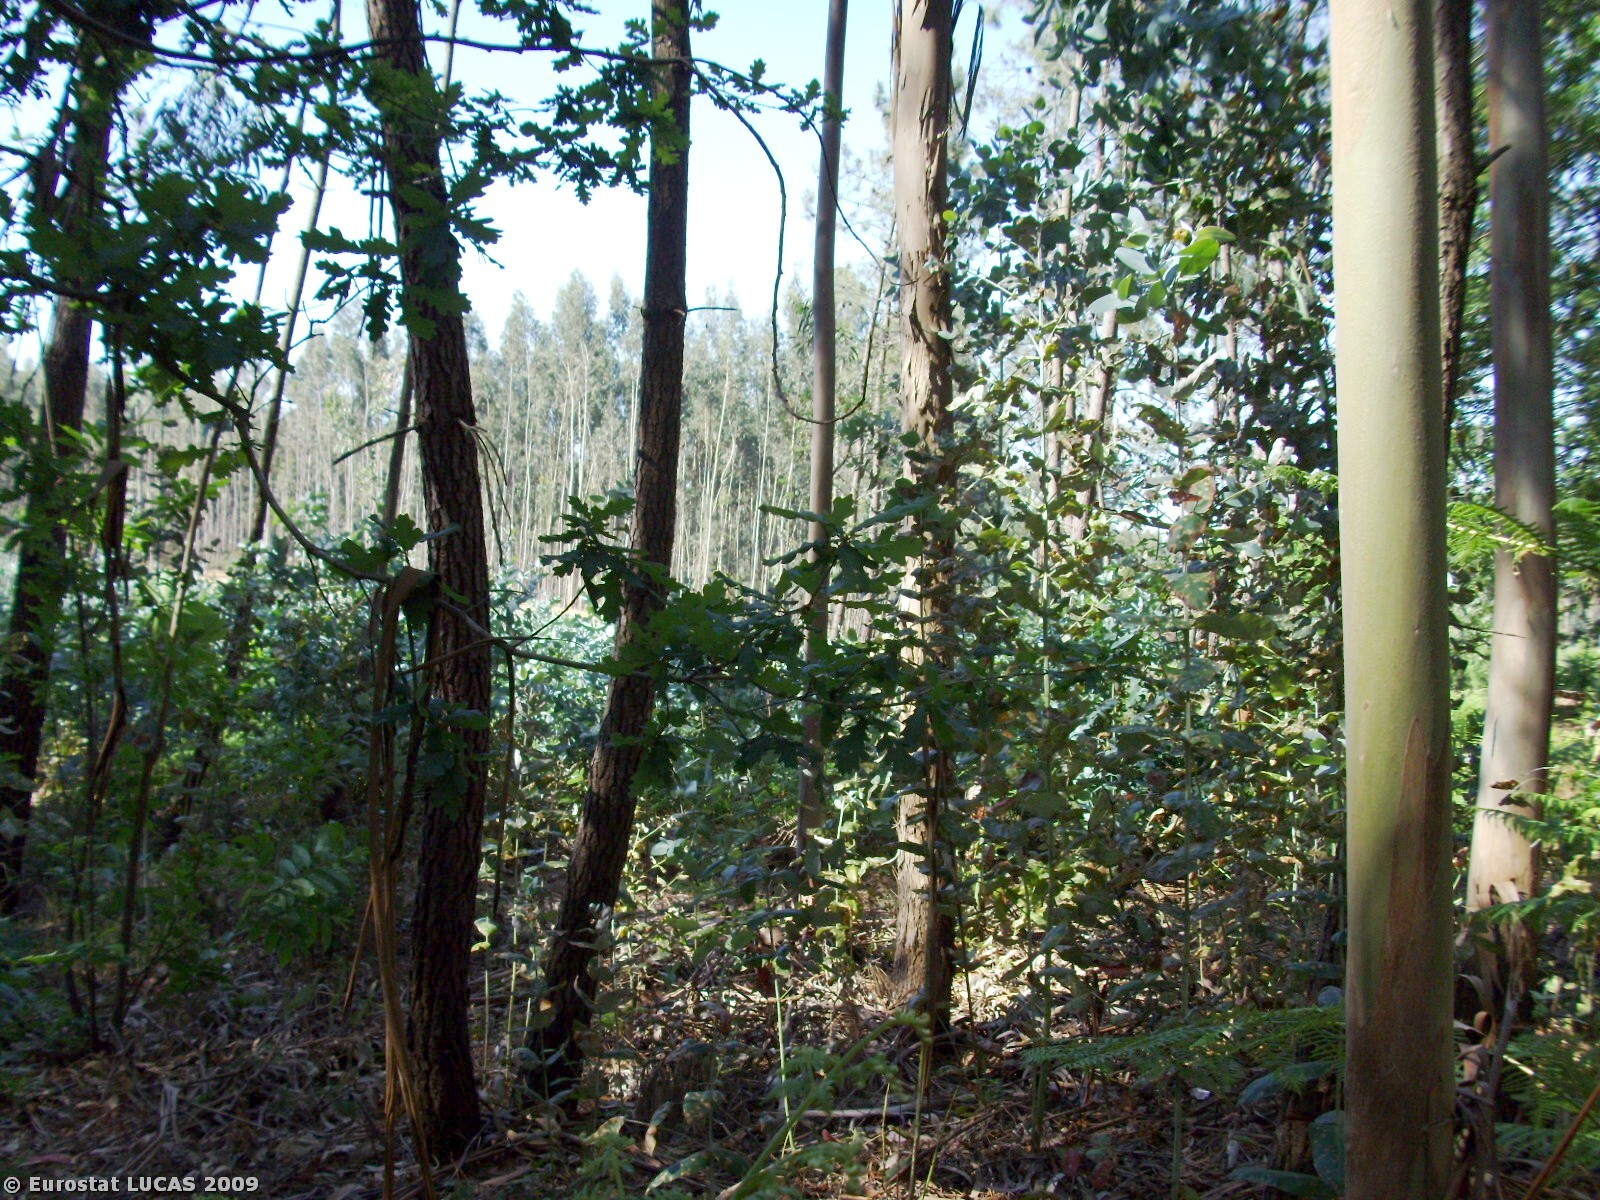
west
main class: Woodland
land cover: Broadleaved woodland
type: plantations and self-sown exotic forest
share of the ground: > 75 %
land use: Forestry
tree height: > 5 m
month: May
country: PT
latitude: 40.6708
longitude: -8.4156
